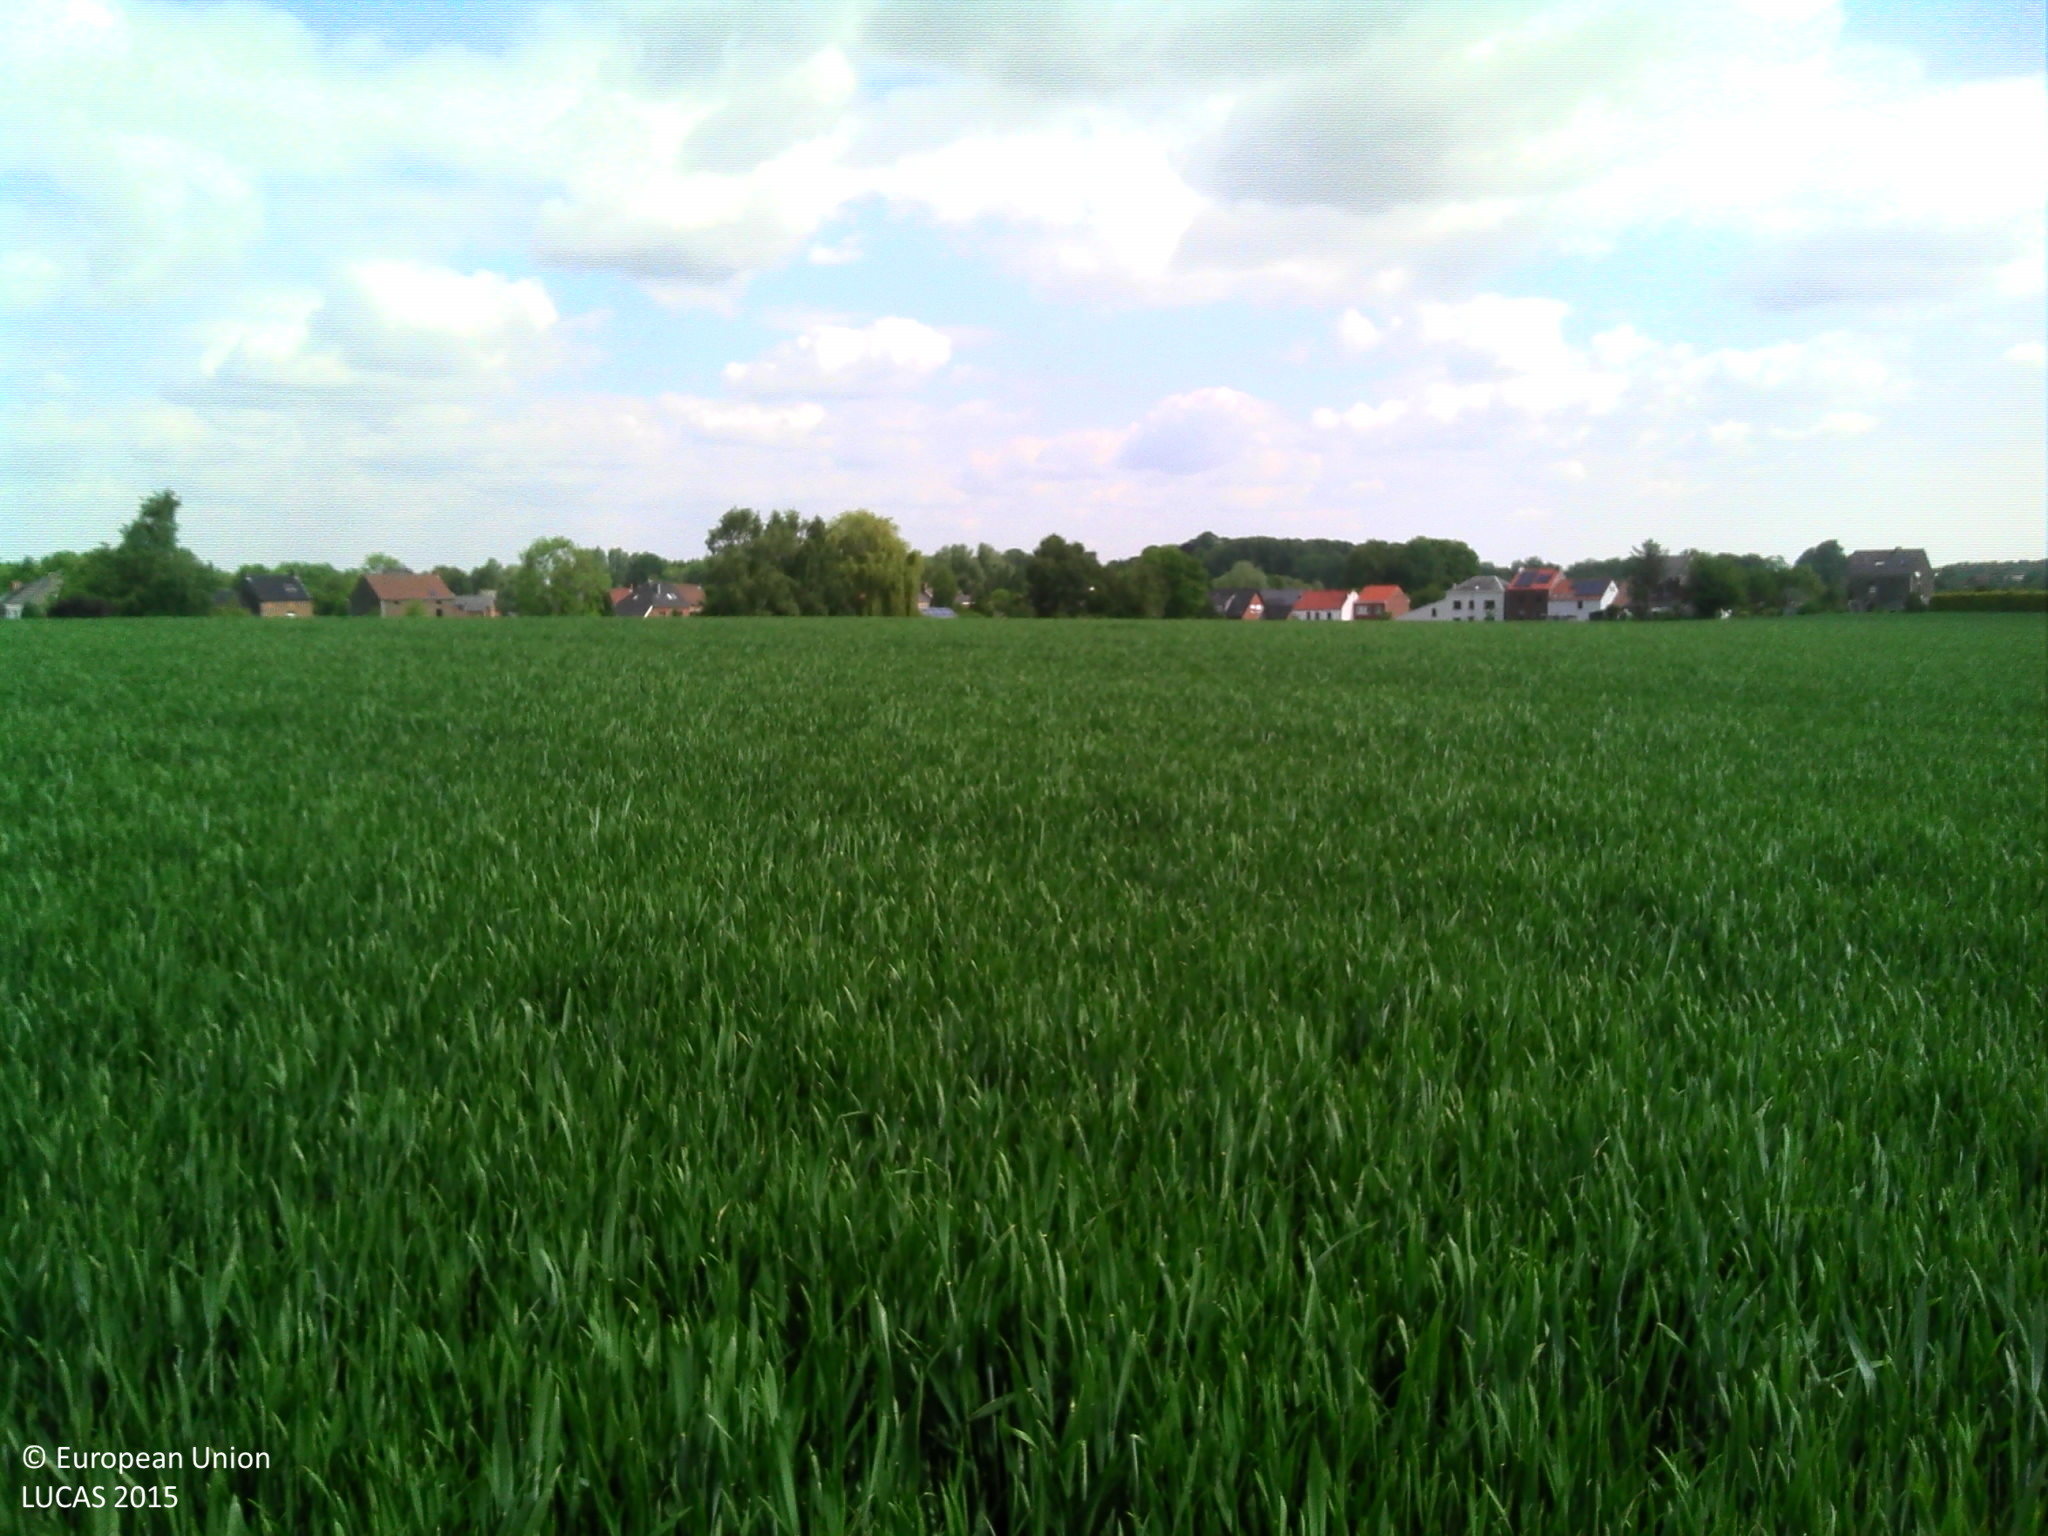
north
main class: Cropland
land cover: Common wheat
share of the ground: > 75 %
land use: Agriculture (excluding fallow land and kitchen gardens)
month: May
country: BE
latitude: 50.5399
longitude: 4.5353
